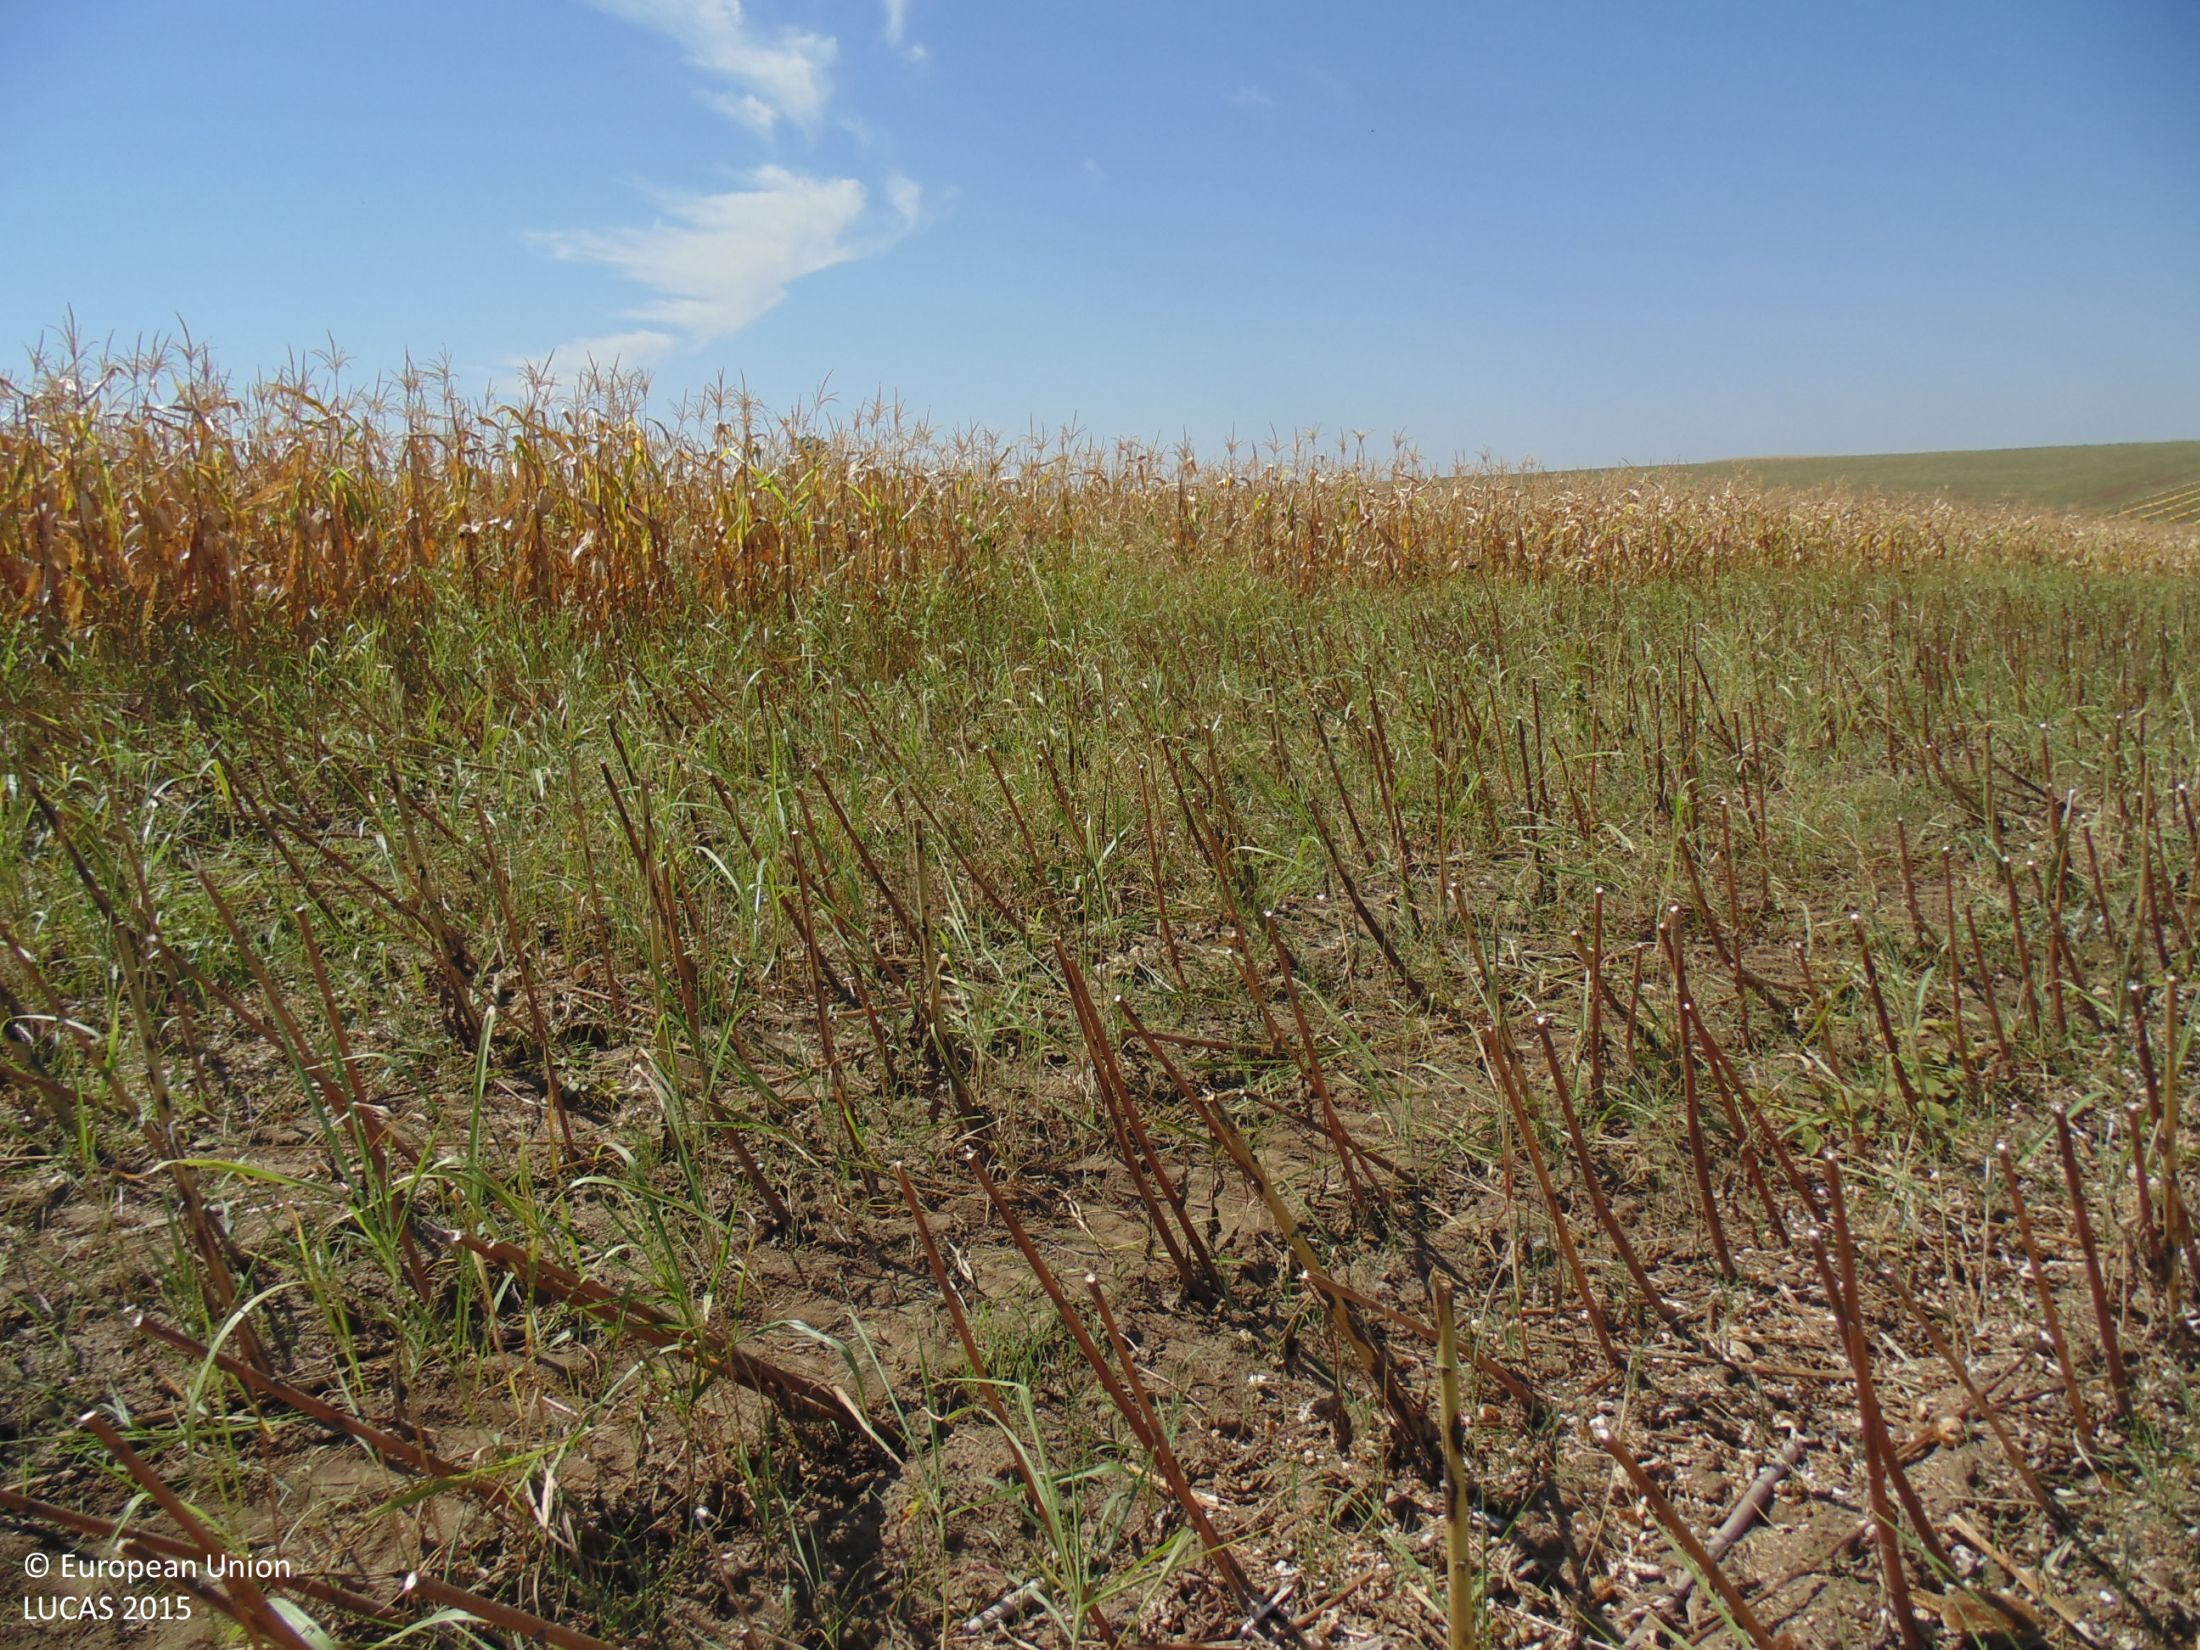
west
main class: Cropland
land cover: Sunflower
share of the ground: 50 - 75 %
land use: Agriculture (excluding fallow land and kitchen gardens)
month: September
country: BG
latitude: 43.9341
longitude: 27.0788
